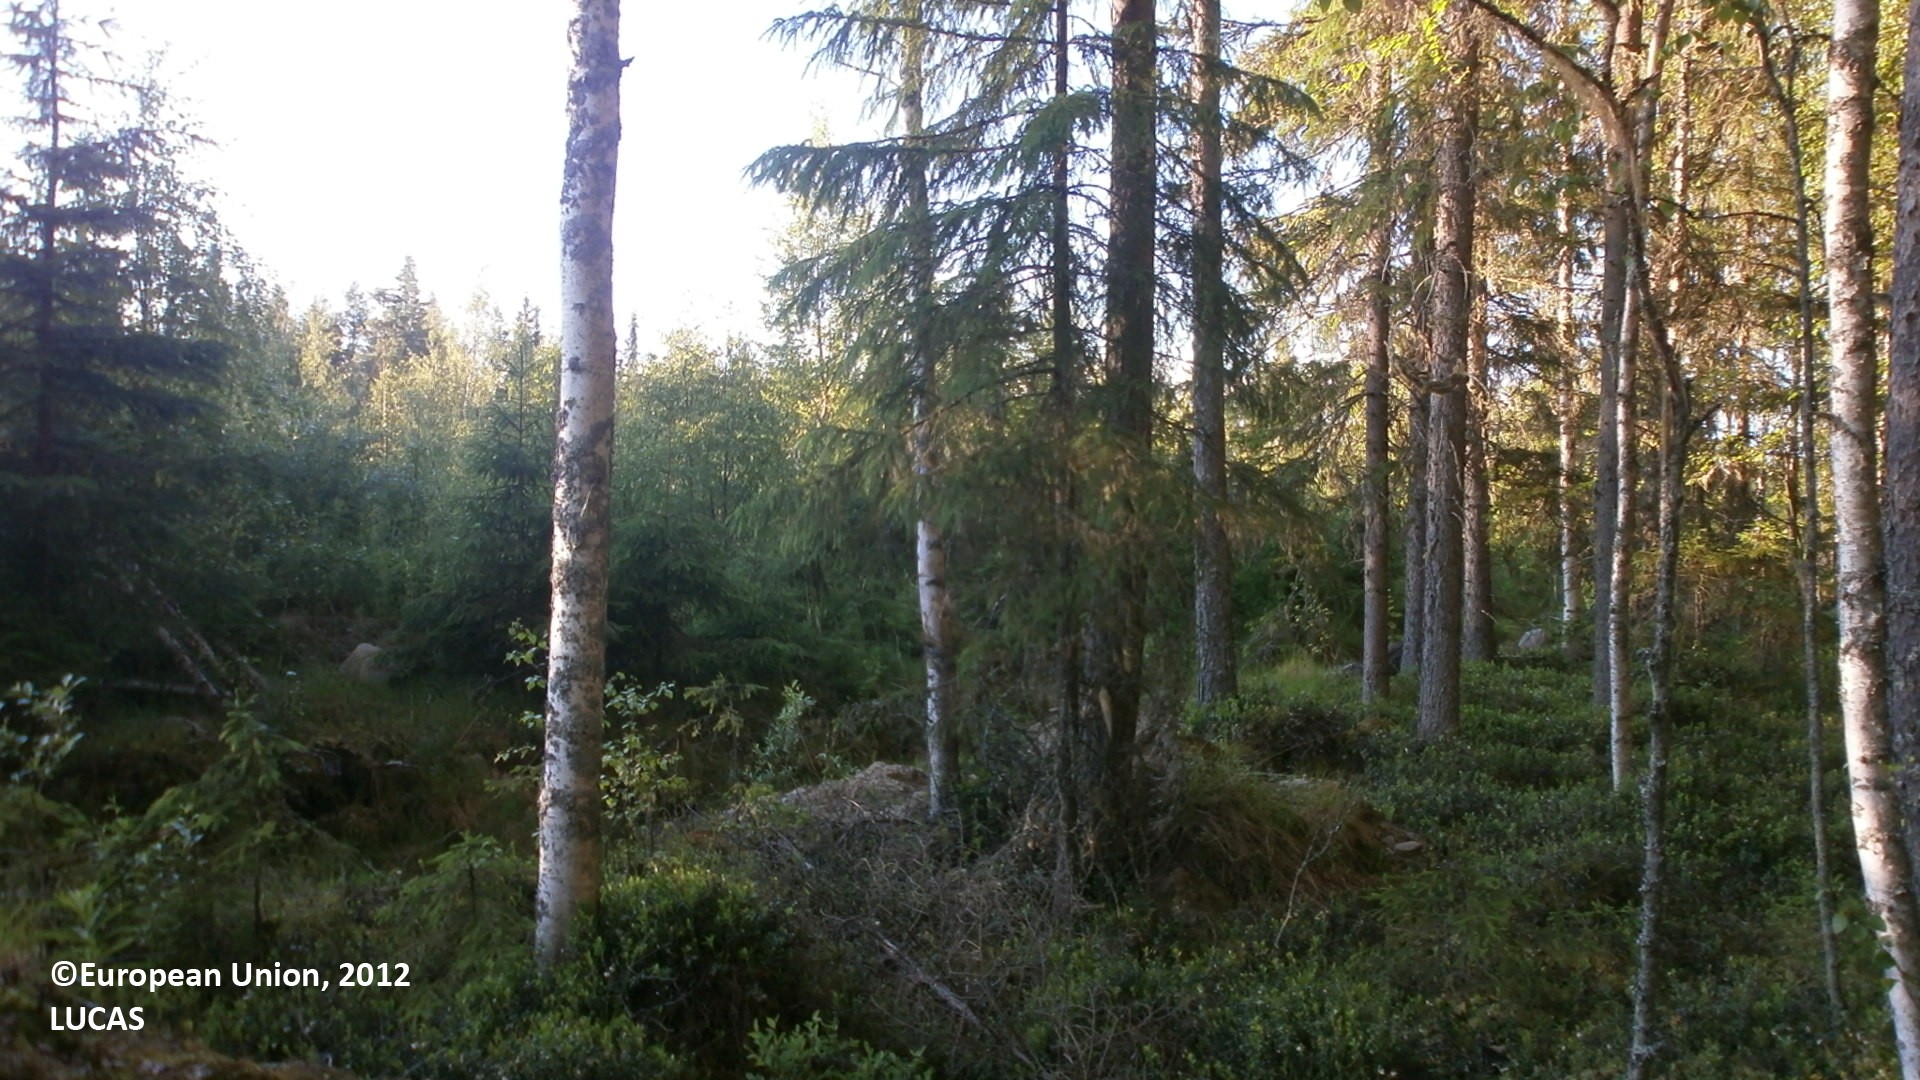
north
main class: Woodland
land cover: Spruce dominated mixed woodland
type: boreal forest
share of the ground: > 75 %
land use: Forestry
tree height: > 5 m
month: July
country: FI
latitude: 64.0097
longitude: 24.8276
